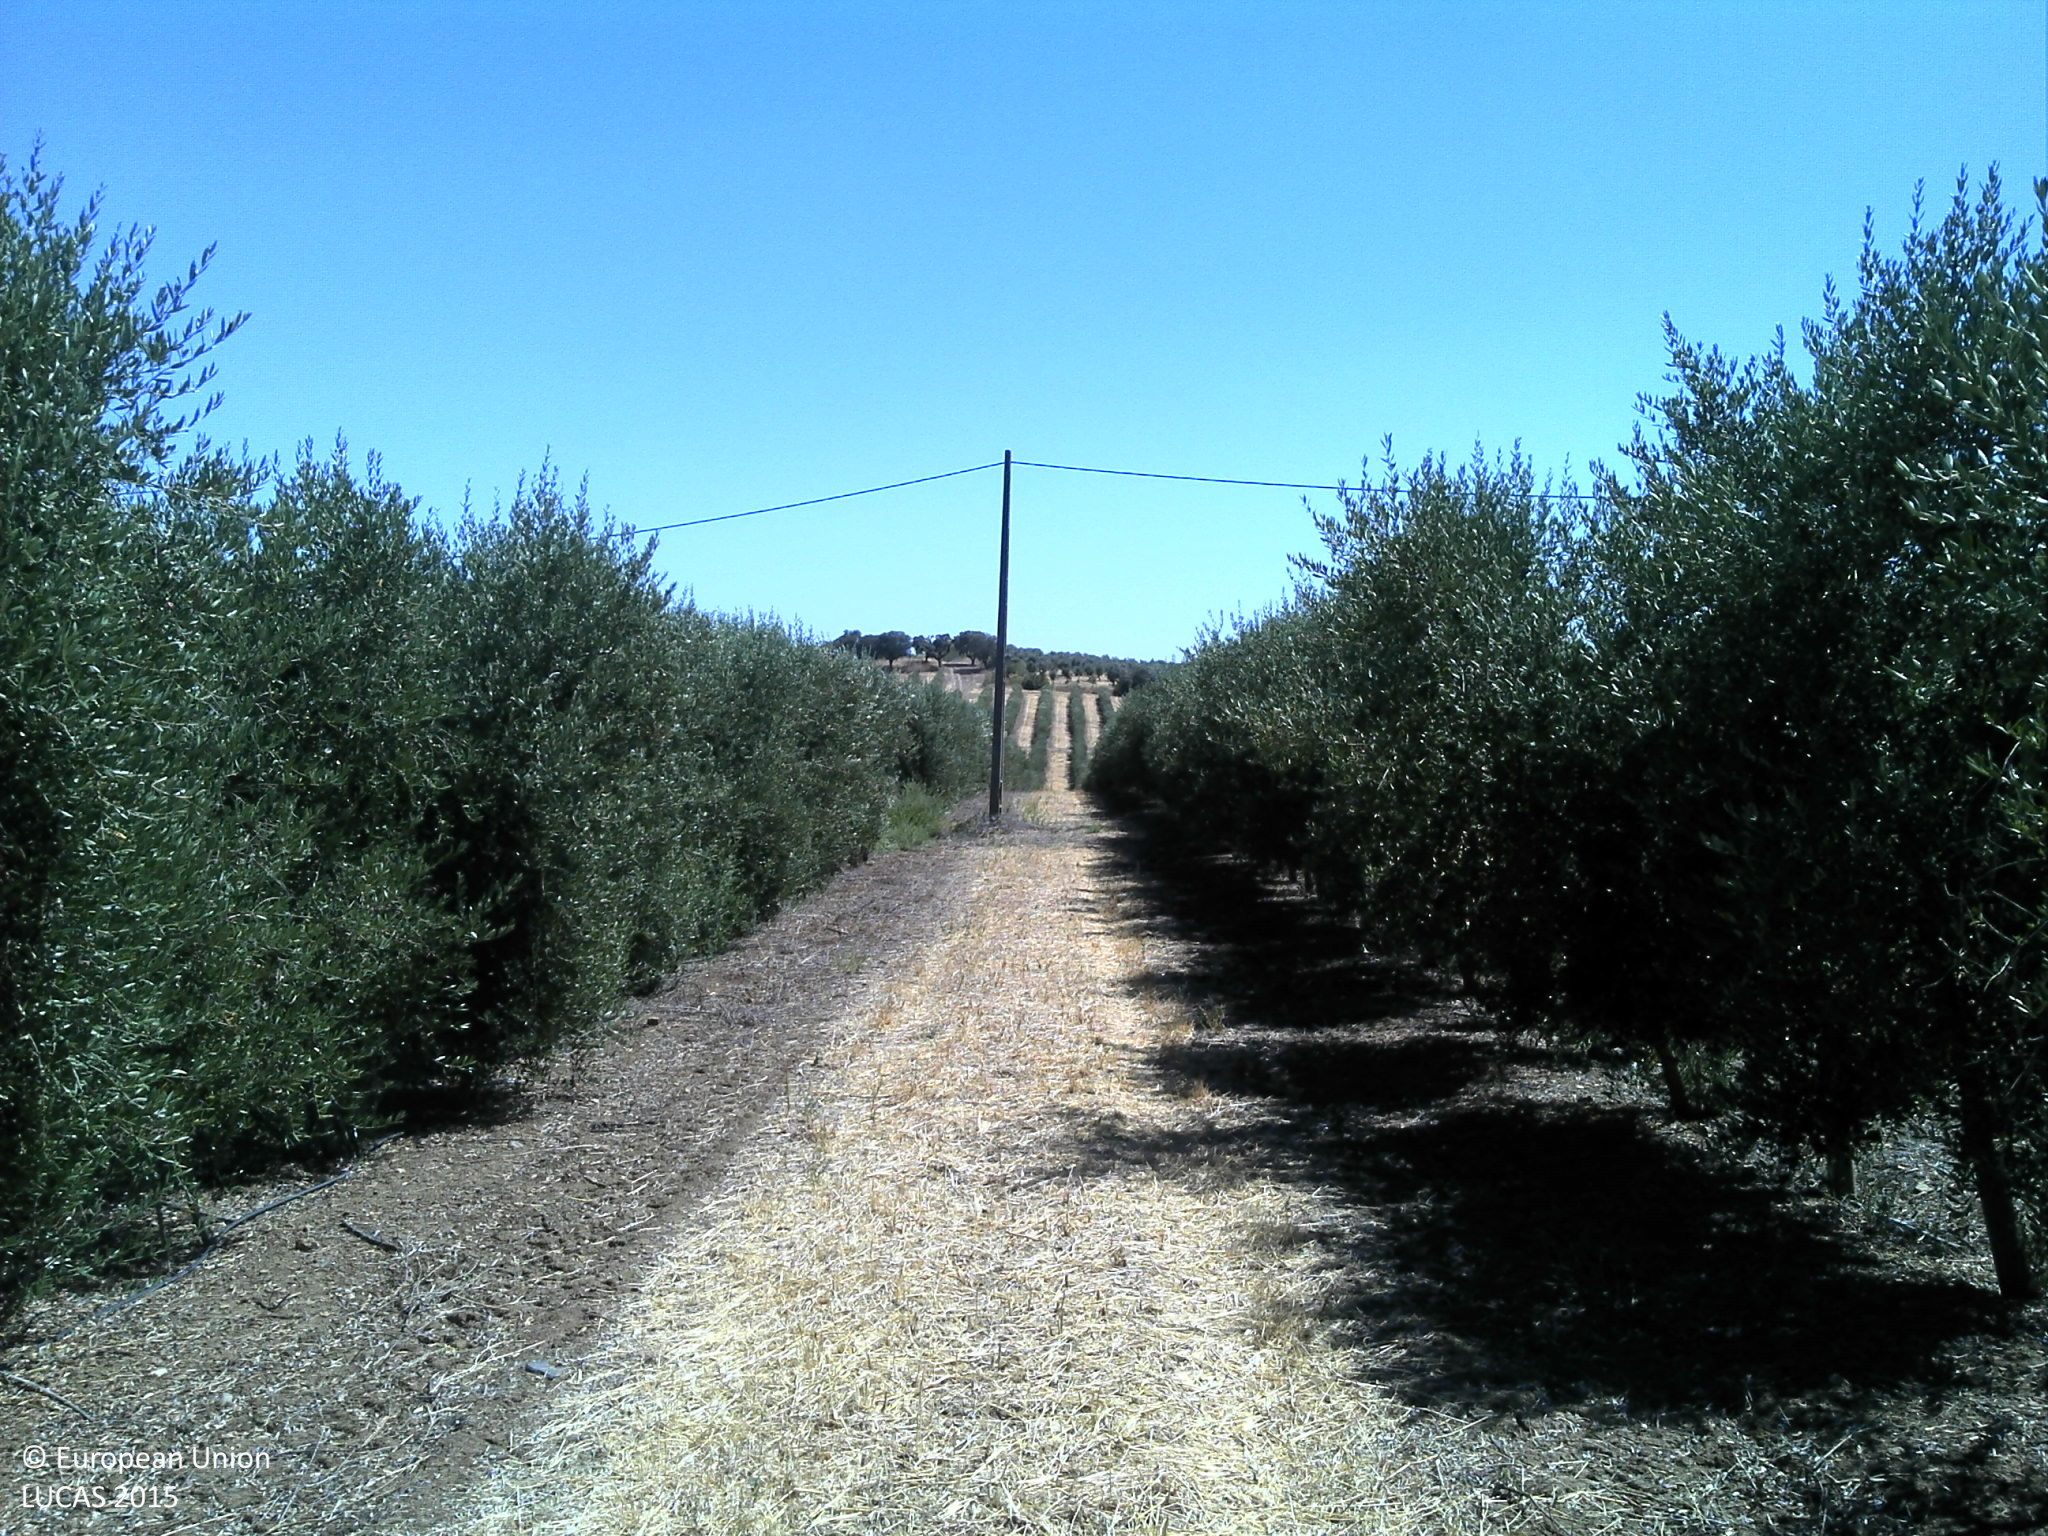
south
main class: Cropland
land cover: Olive groves
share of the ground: 25 - 50 %
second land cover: Grassland without tree/shrub cover
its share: 25 - 50 %
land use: Agriculture (excluding fallow land and kitchen gardens)
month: July
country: PT
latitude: 39.0026
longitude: -7.5561
